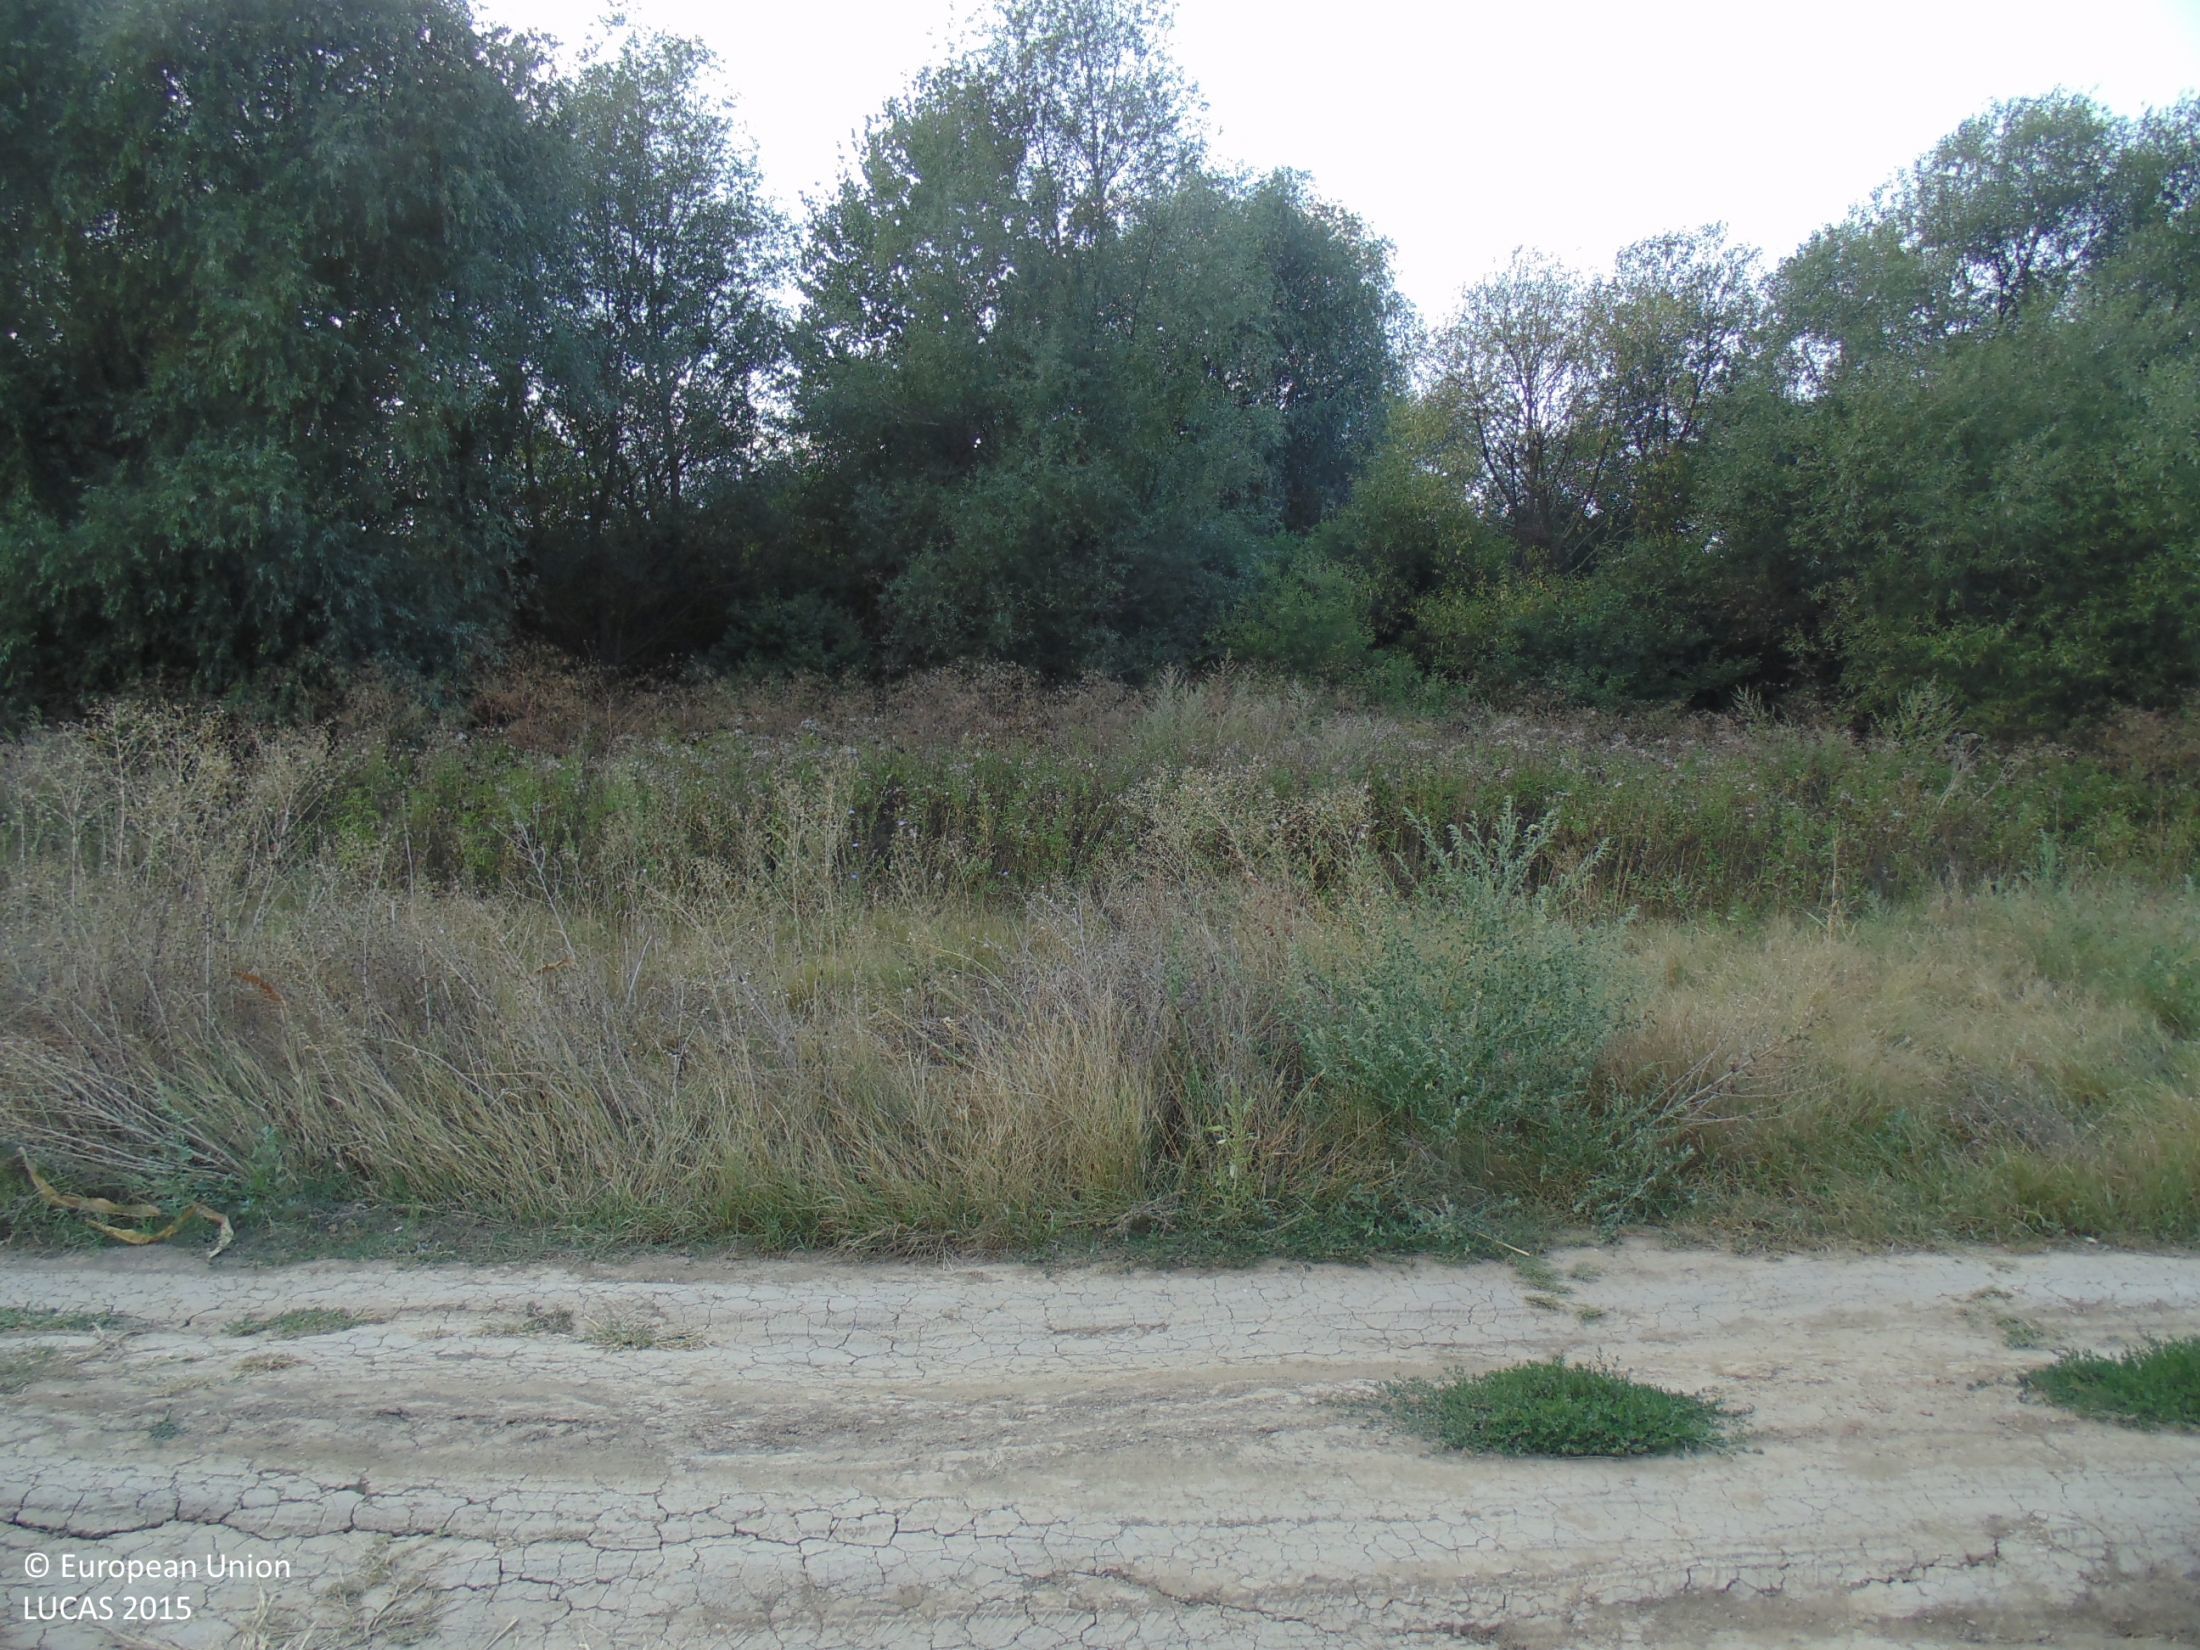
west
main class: Cropland
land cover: Common wheat
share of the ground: < 10 %
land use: Agriculture (excluding fallow land and kitchen gardens)
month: September
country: BG
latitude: 44.0701
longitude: 27.1459
